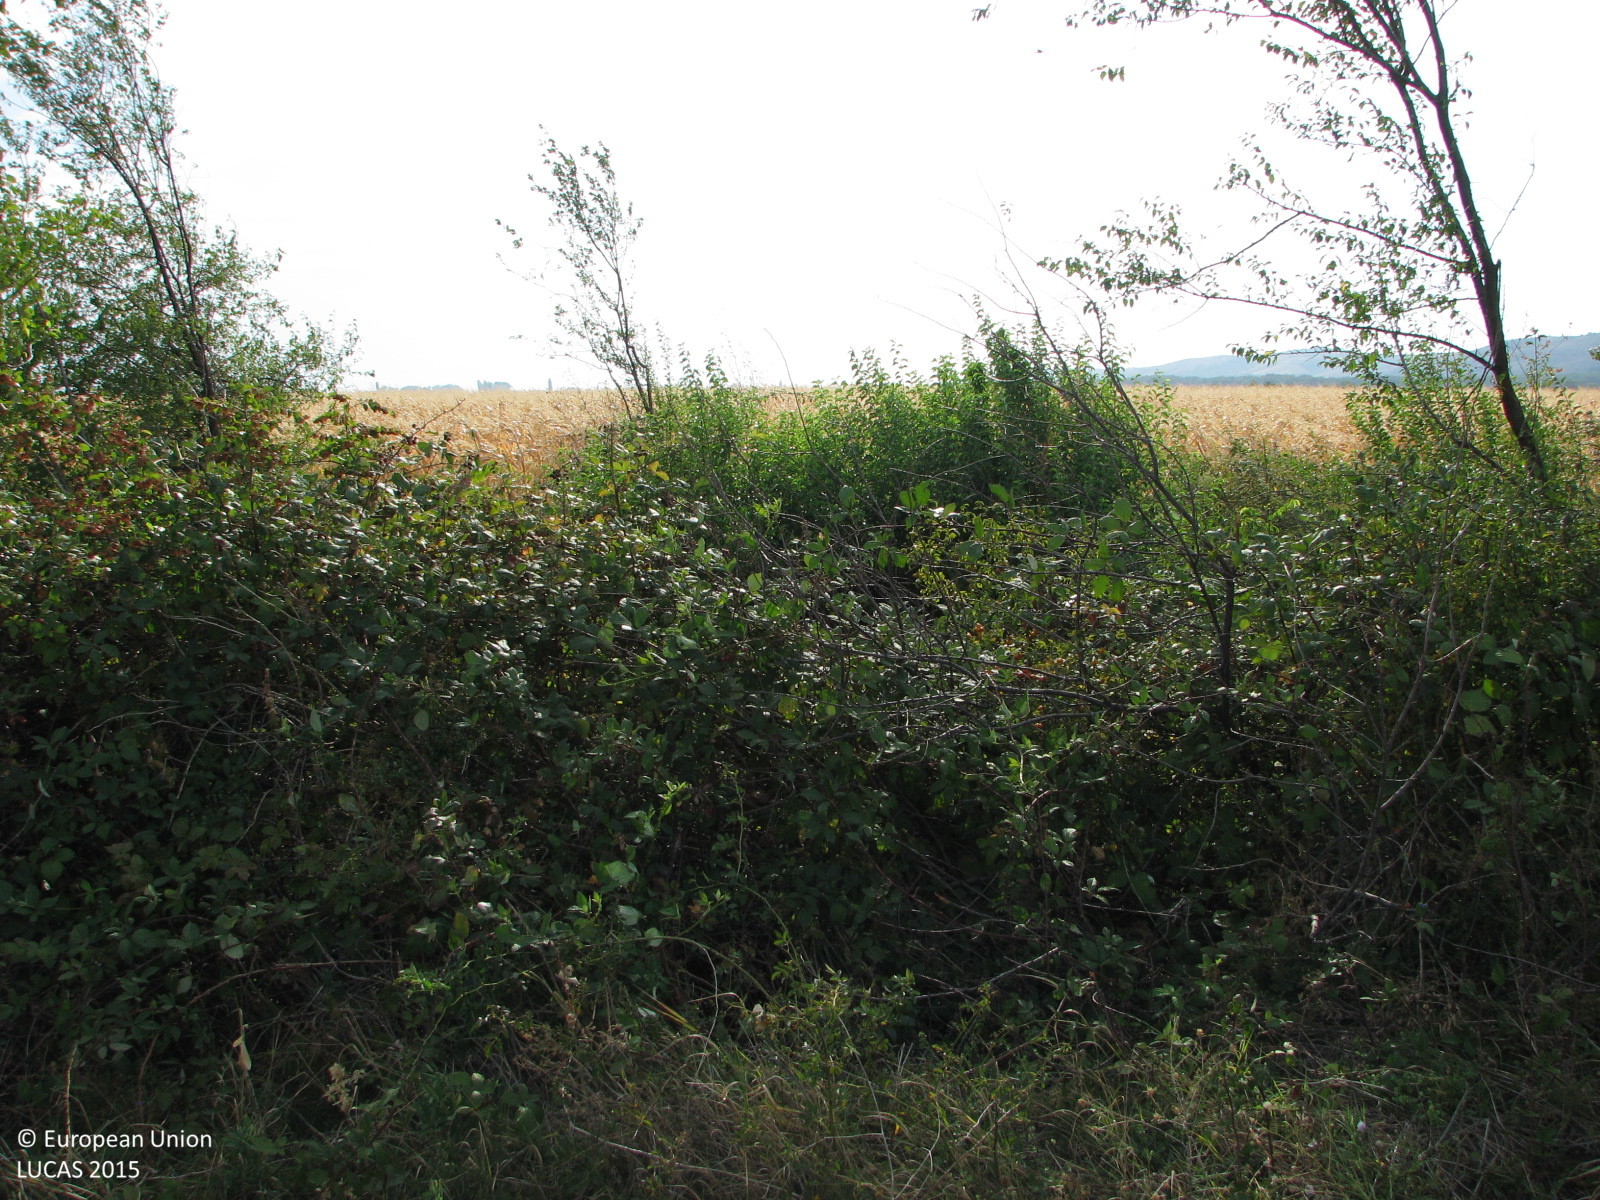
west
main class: Cropland
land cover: Maize
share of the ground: > 75 %
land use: Agriculture (excluding fallow land and kitchen gardens)
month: September
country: BG
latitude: 42.5211
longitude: 25.9407
